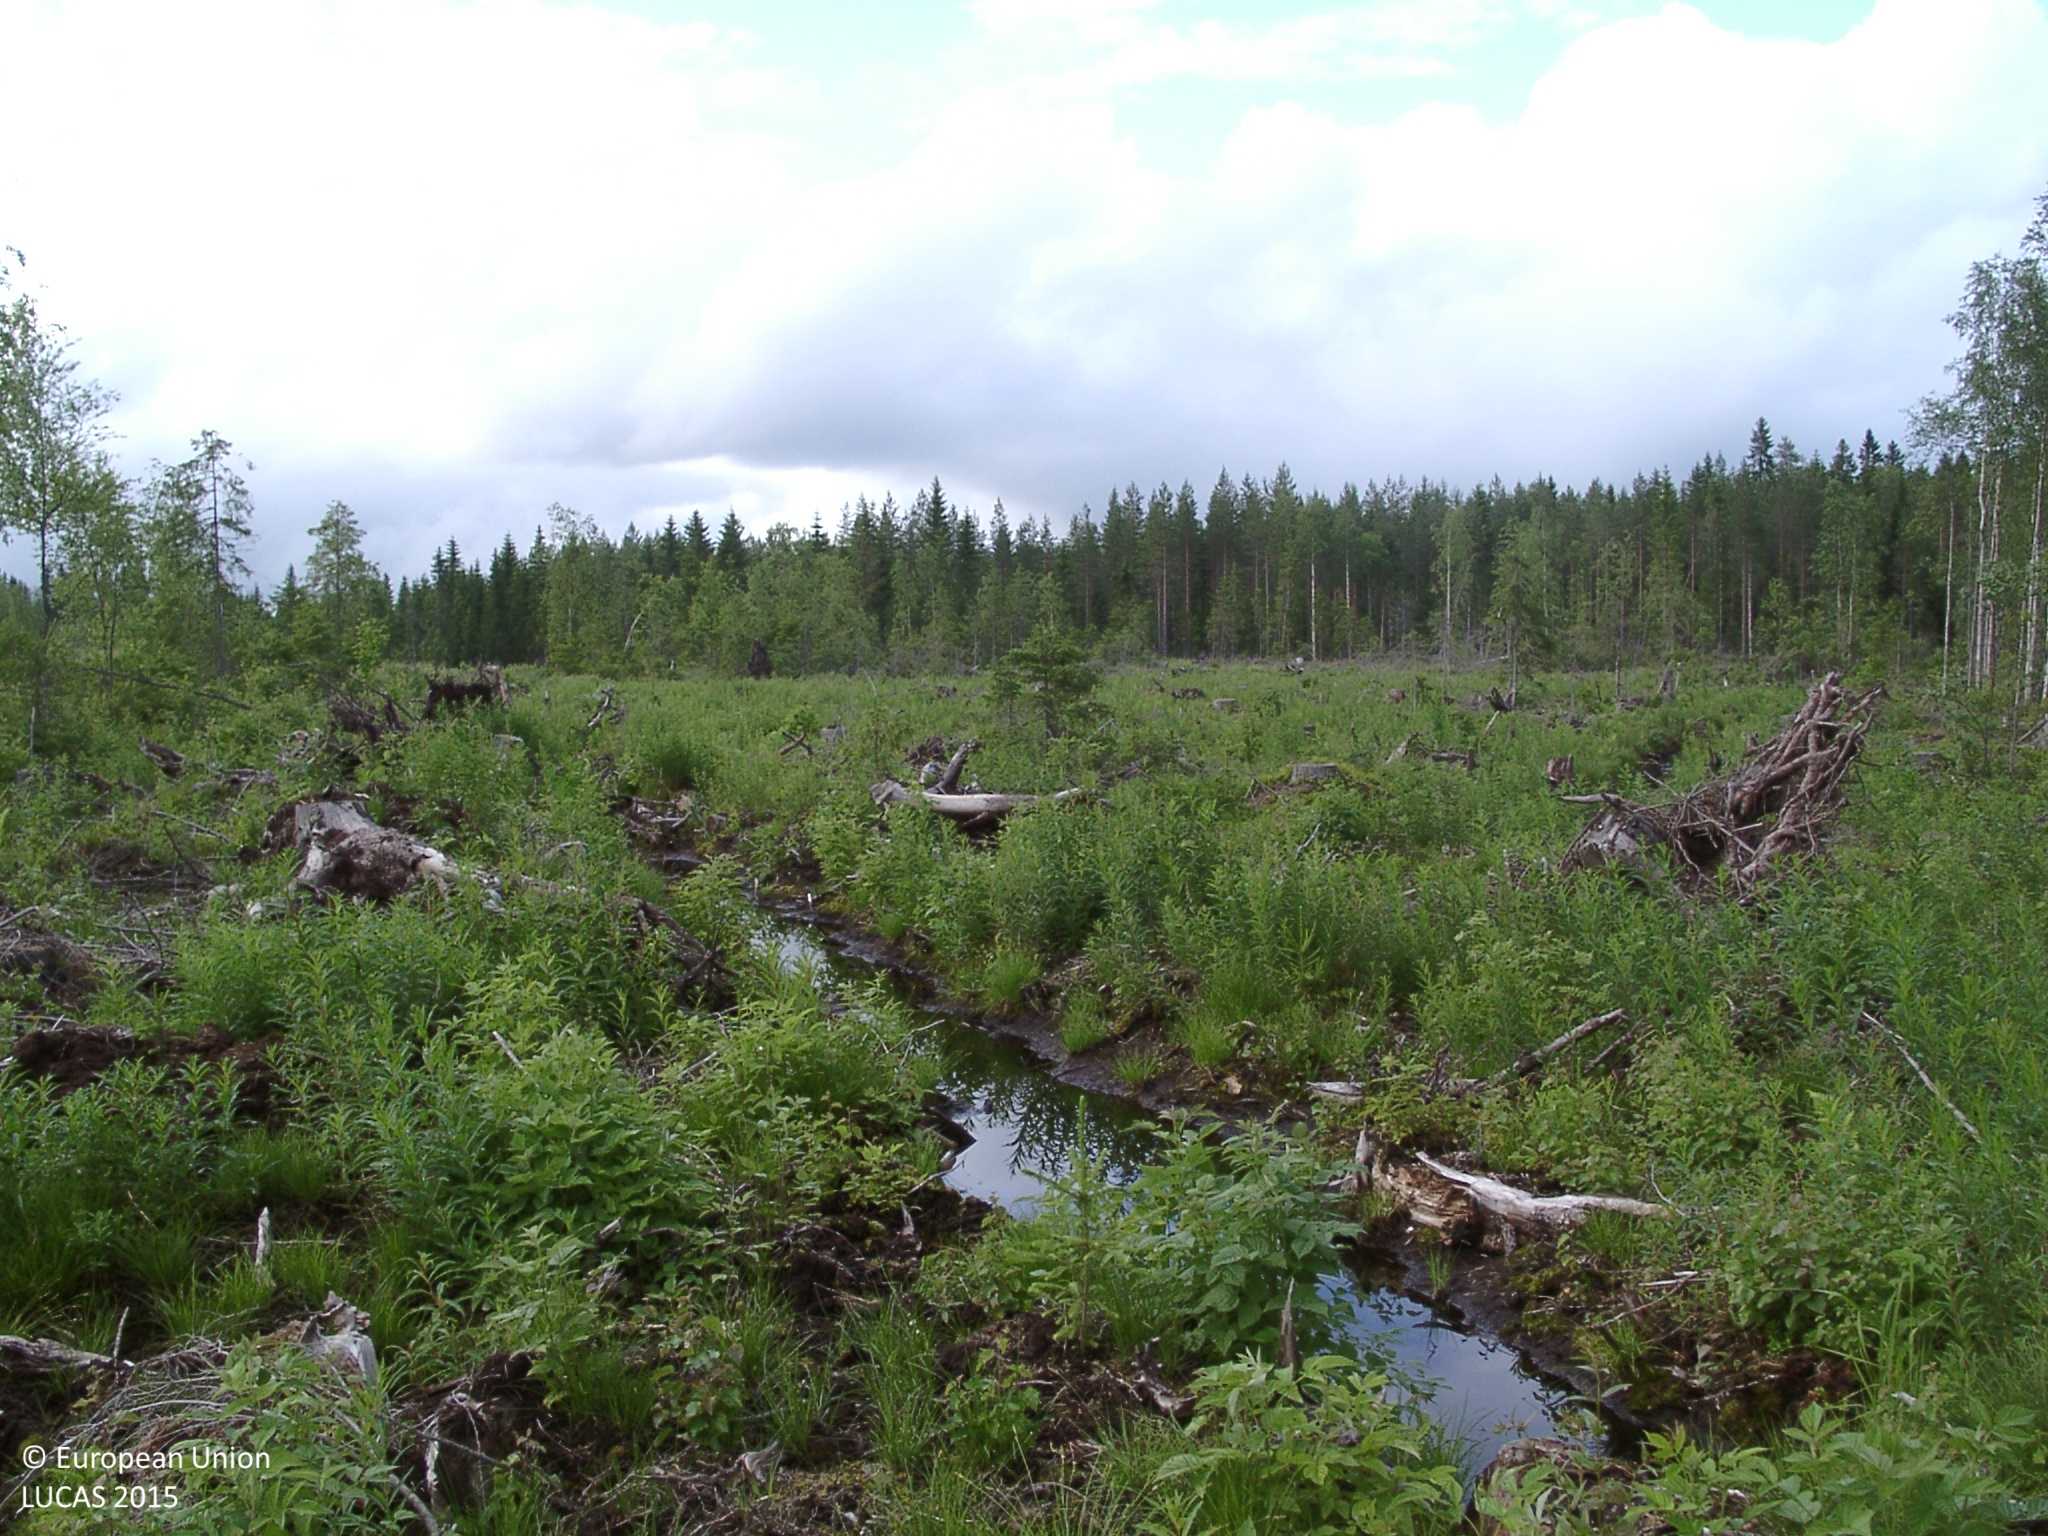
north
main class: Shrubland
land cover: Shrubland with sparse tree cover
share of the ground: 10 - 25 %
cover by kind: herbaceous plants 40 %, shrubs 15 %, broadleaved forest trees 5 %, unconsolidated bare surface 5 %
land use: Forestry
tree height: < 5 m
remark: Nursery
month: July
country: FI
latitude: 62.0783
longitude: 25.3304
